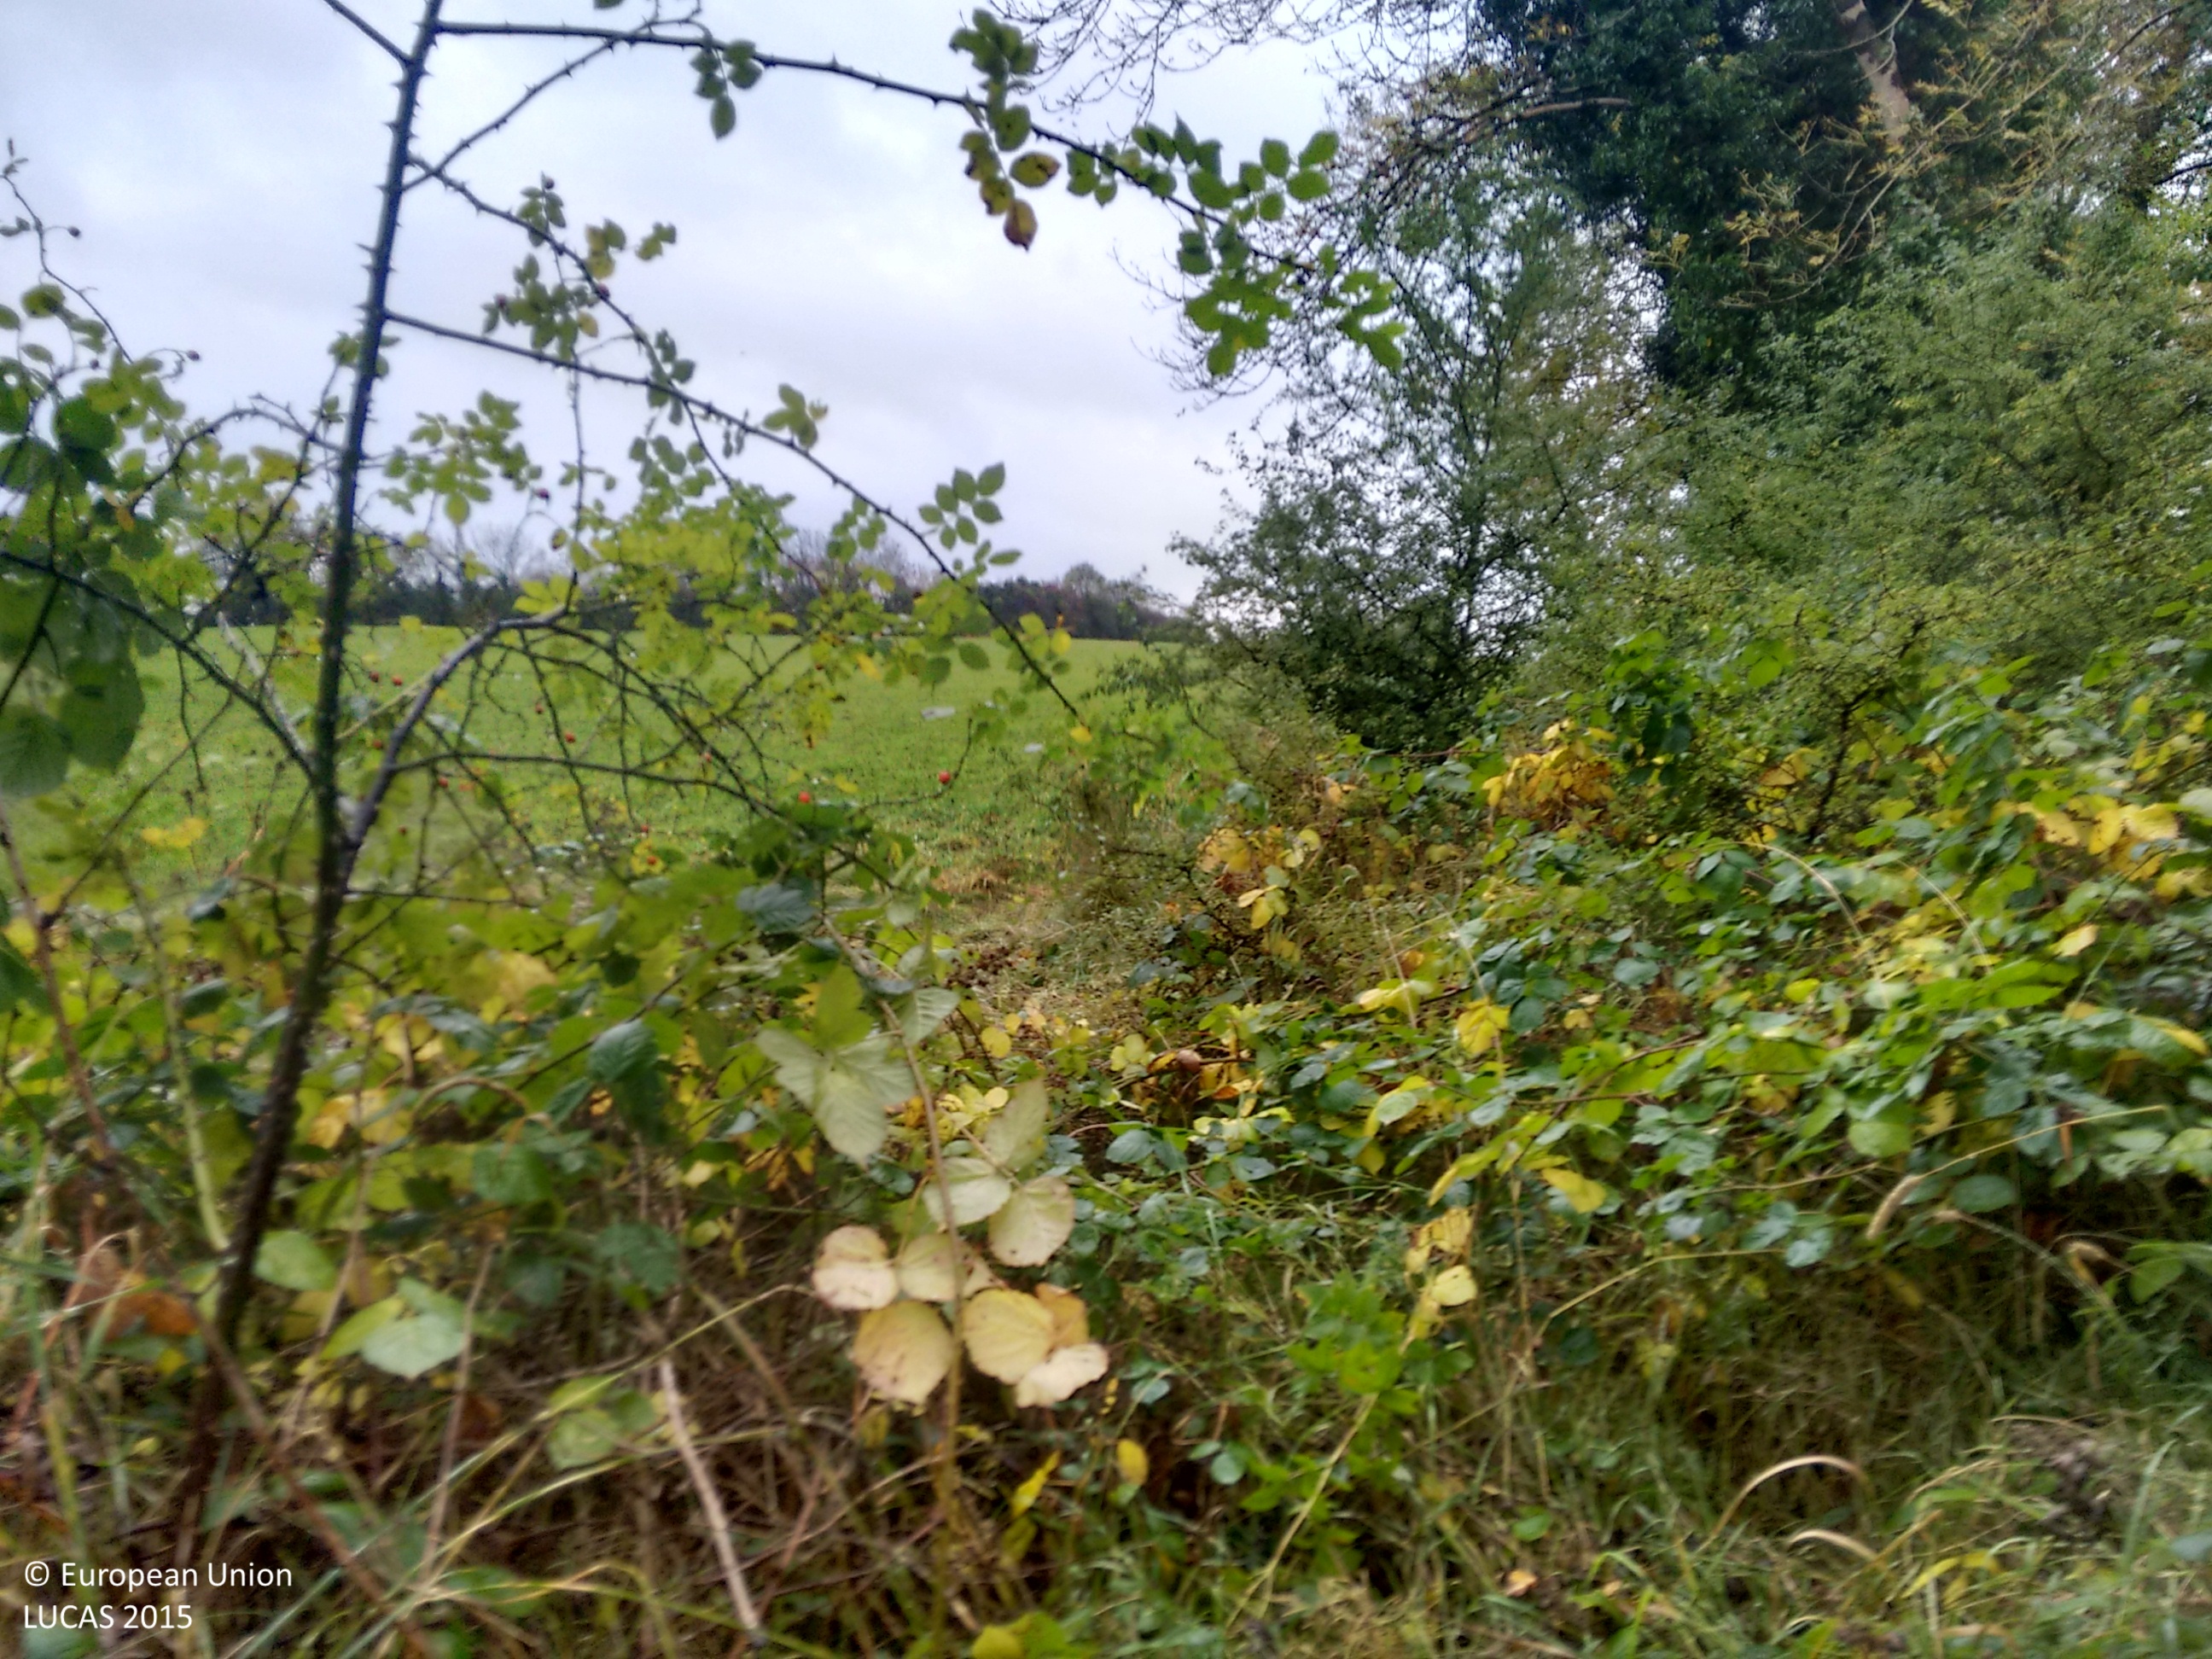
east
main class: Grassland
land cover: Grassland without tree/shrub cover
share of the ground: > 75 %
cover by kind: herbaceous plants 100 %
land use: Agriculture (excluding fallow land and kitchen gardens)
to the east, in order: Grassland without tree/shrub cover; Fences; Abandoned hedges; Grassland without tree/shrub cover; Abandoned hedges; Grass margins; Tracks; Grass margins; Abandoned hedges; Grassland without tree/shrub cover
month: October
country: IE
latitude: 53.8704
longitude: -8.0775
